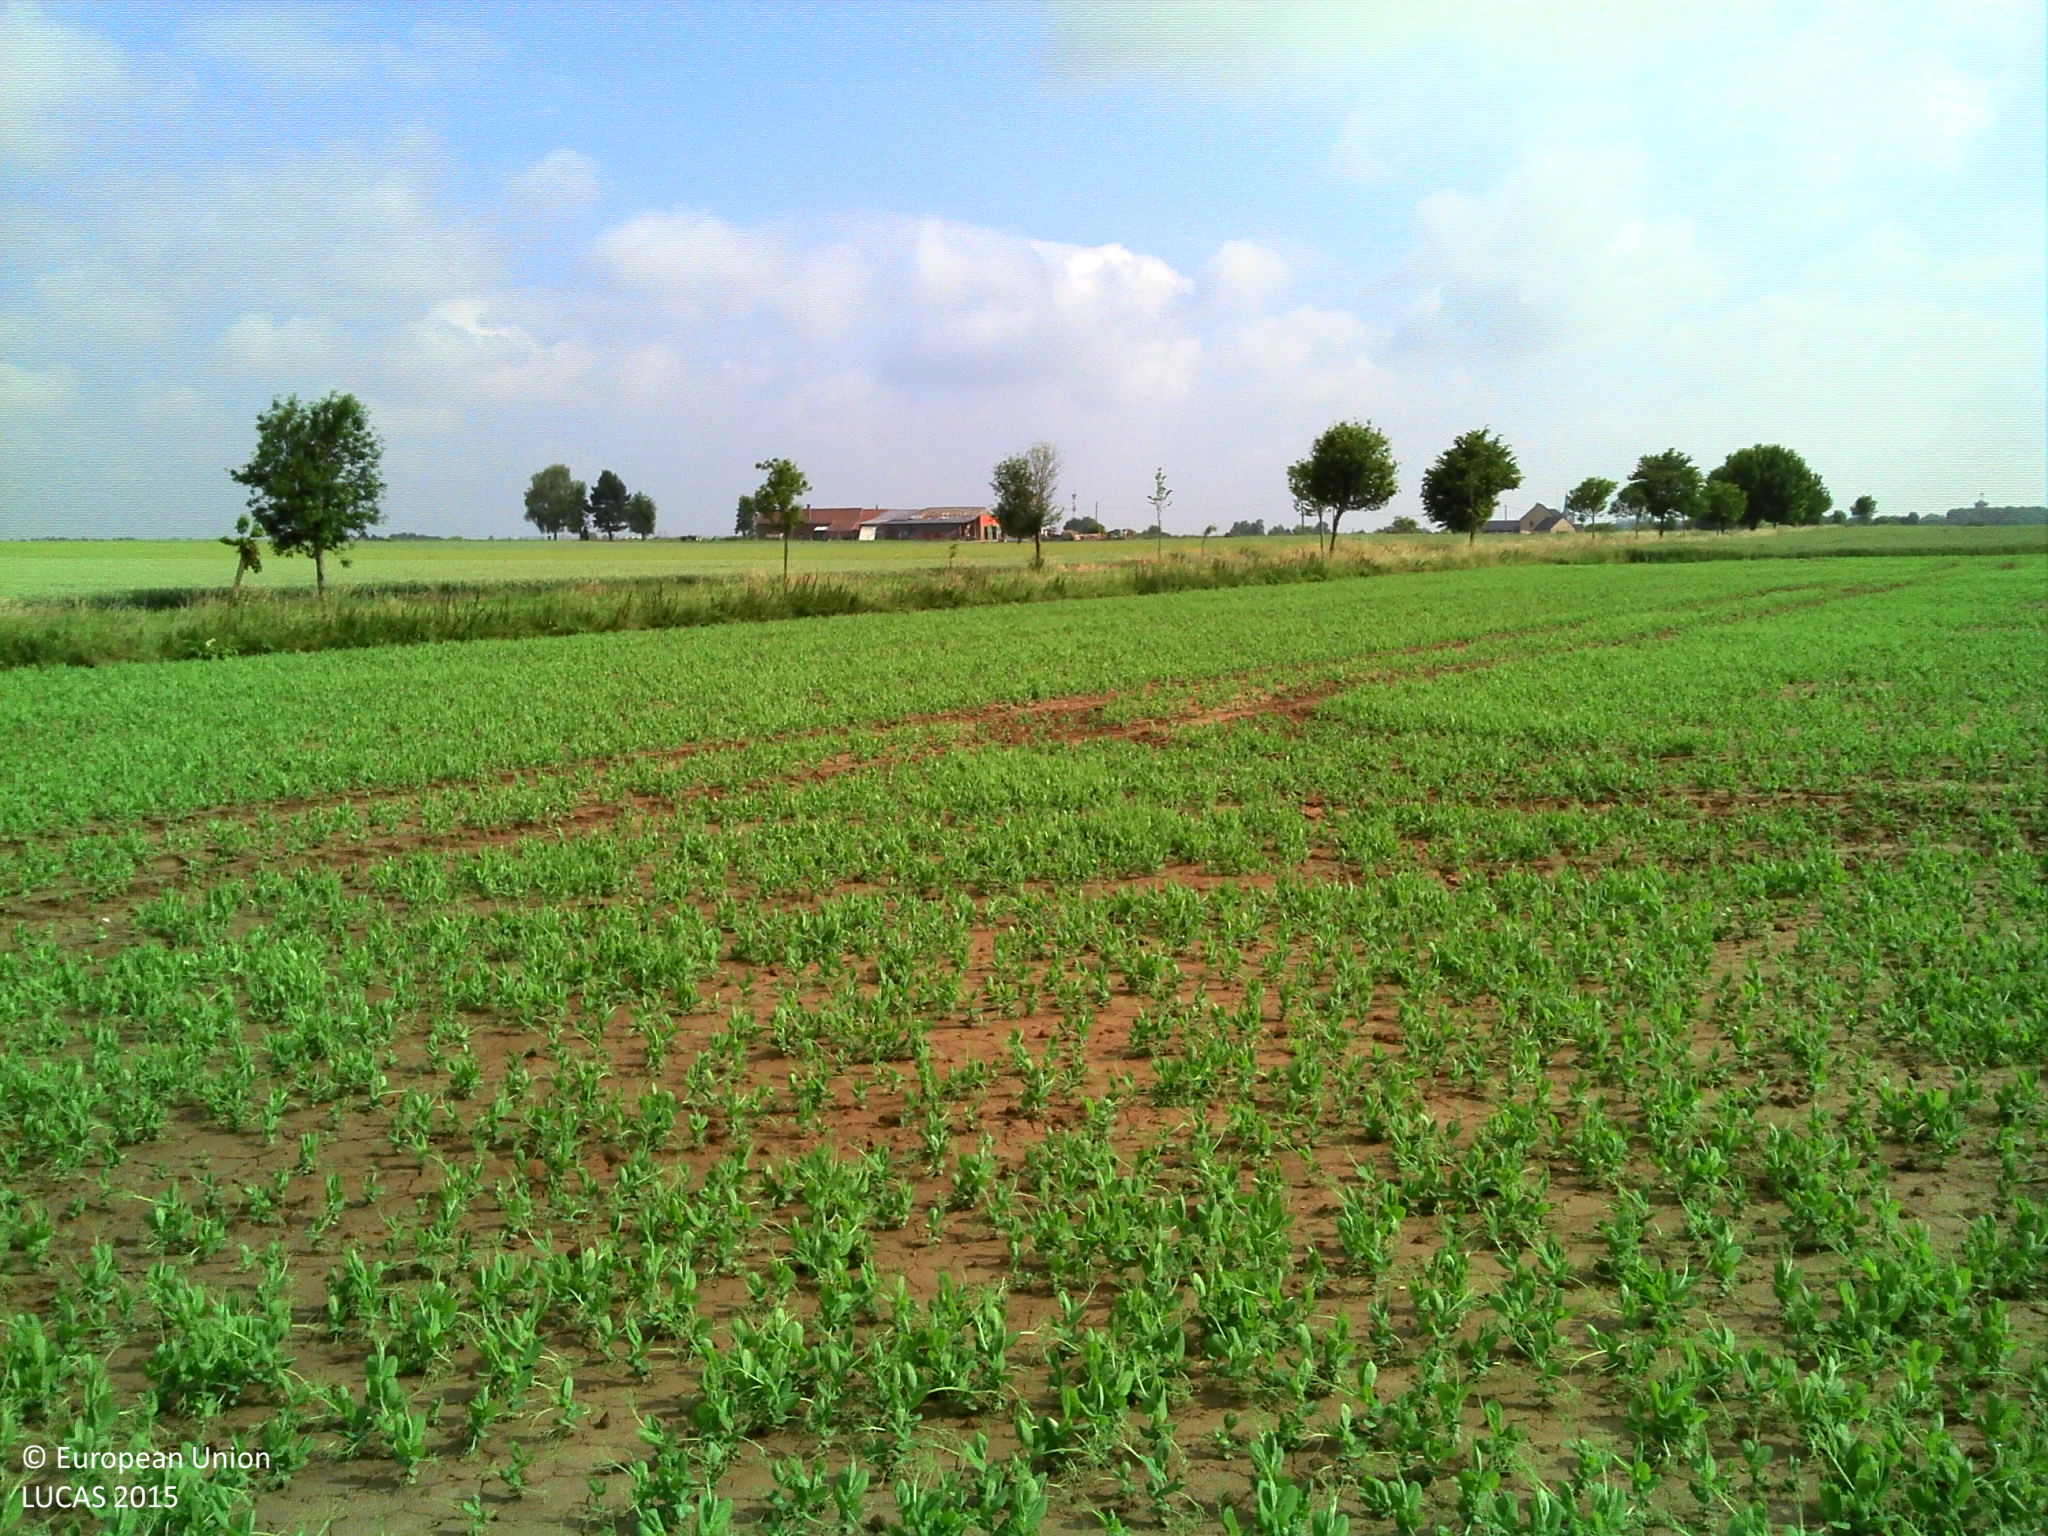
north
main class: Cropland
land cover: Dry pulses
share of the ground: 50 - 75 %
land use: Agriculture (excluding fallow land and kitchen gardens)
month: June
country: BE
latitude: 50.5743
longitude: 3.7945
